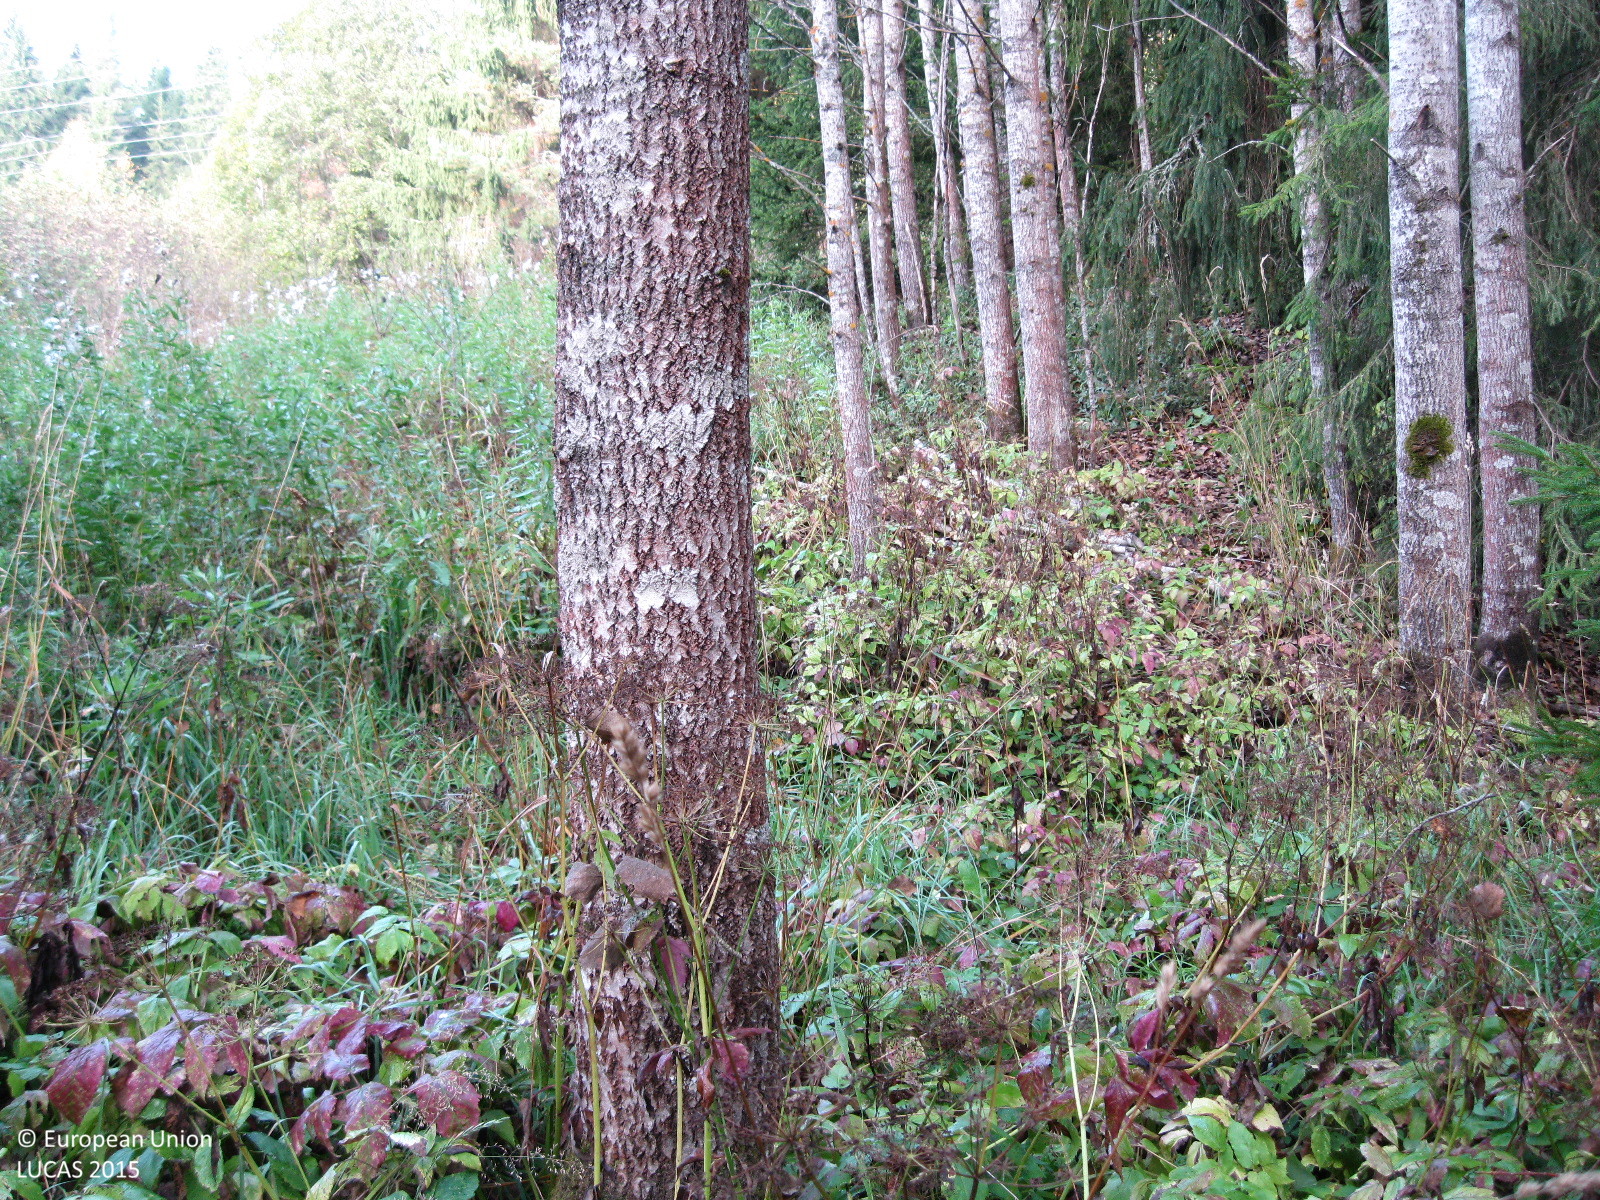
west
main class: Woodland
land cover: Broadleaved woodland
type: boreal forest
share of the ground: 50 - 75 %
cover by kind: broadleaved forest trees 70 %, herbaceous plants 30 %
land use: Forestry
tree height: > 5 m
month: September
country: FI
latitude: 60.9498
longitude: 25.5424
